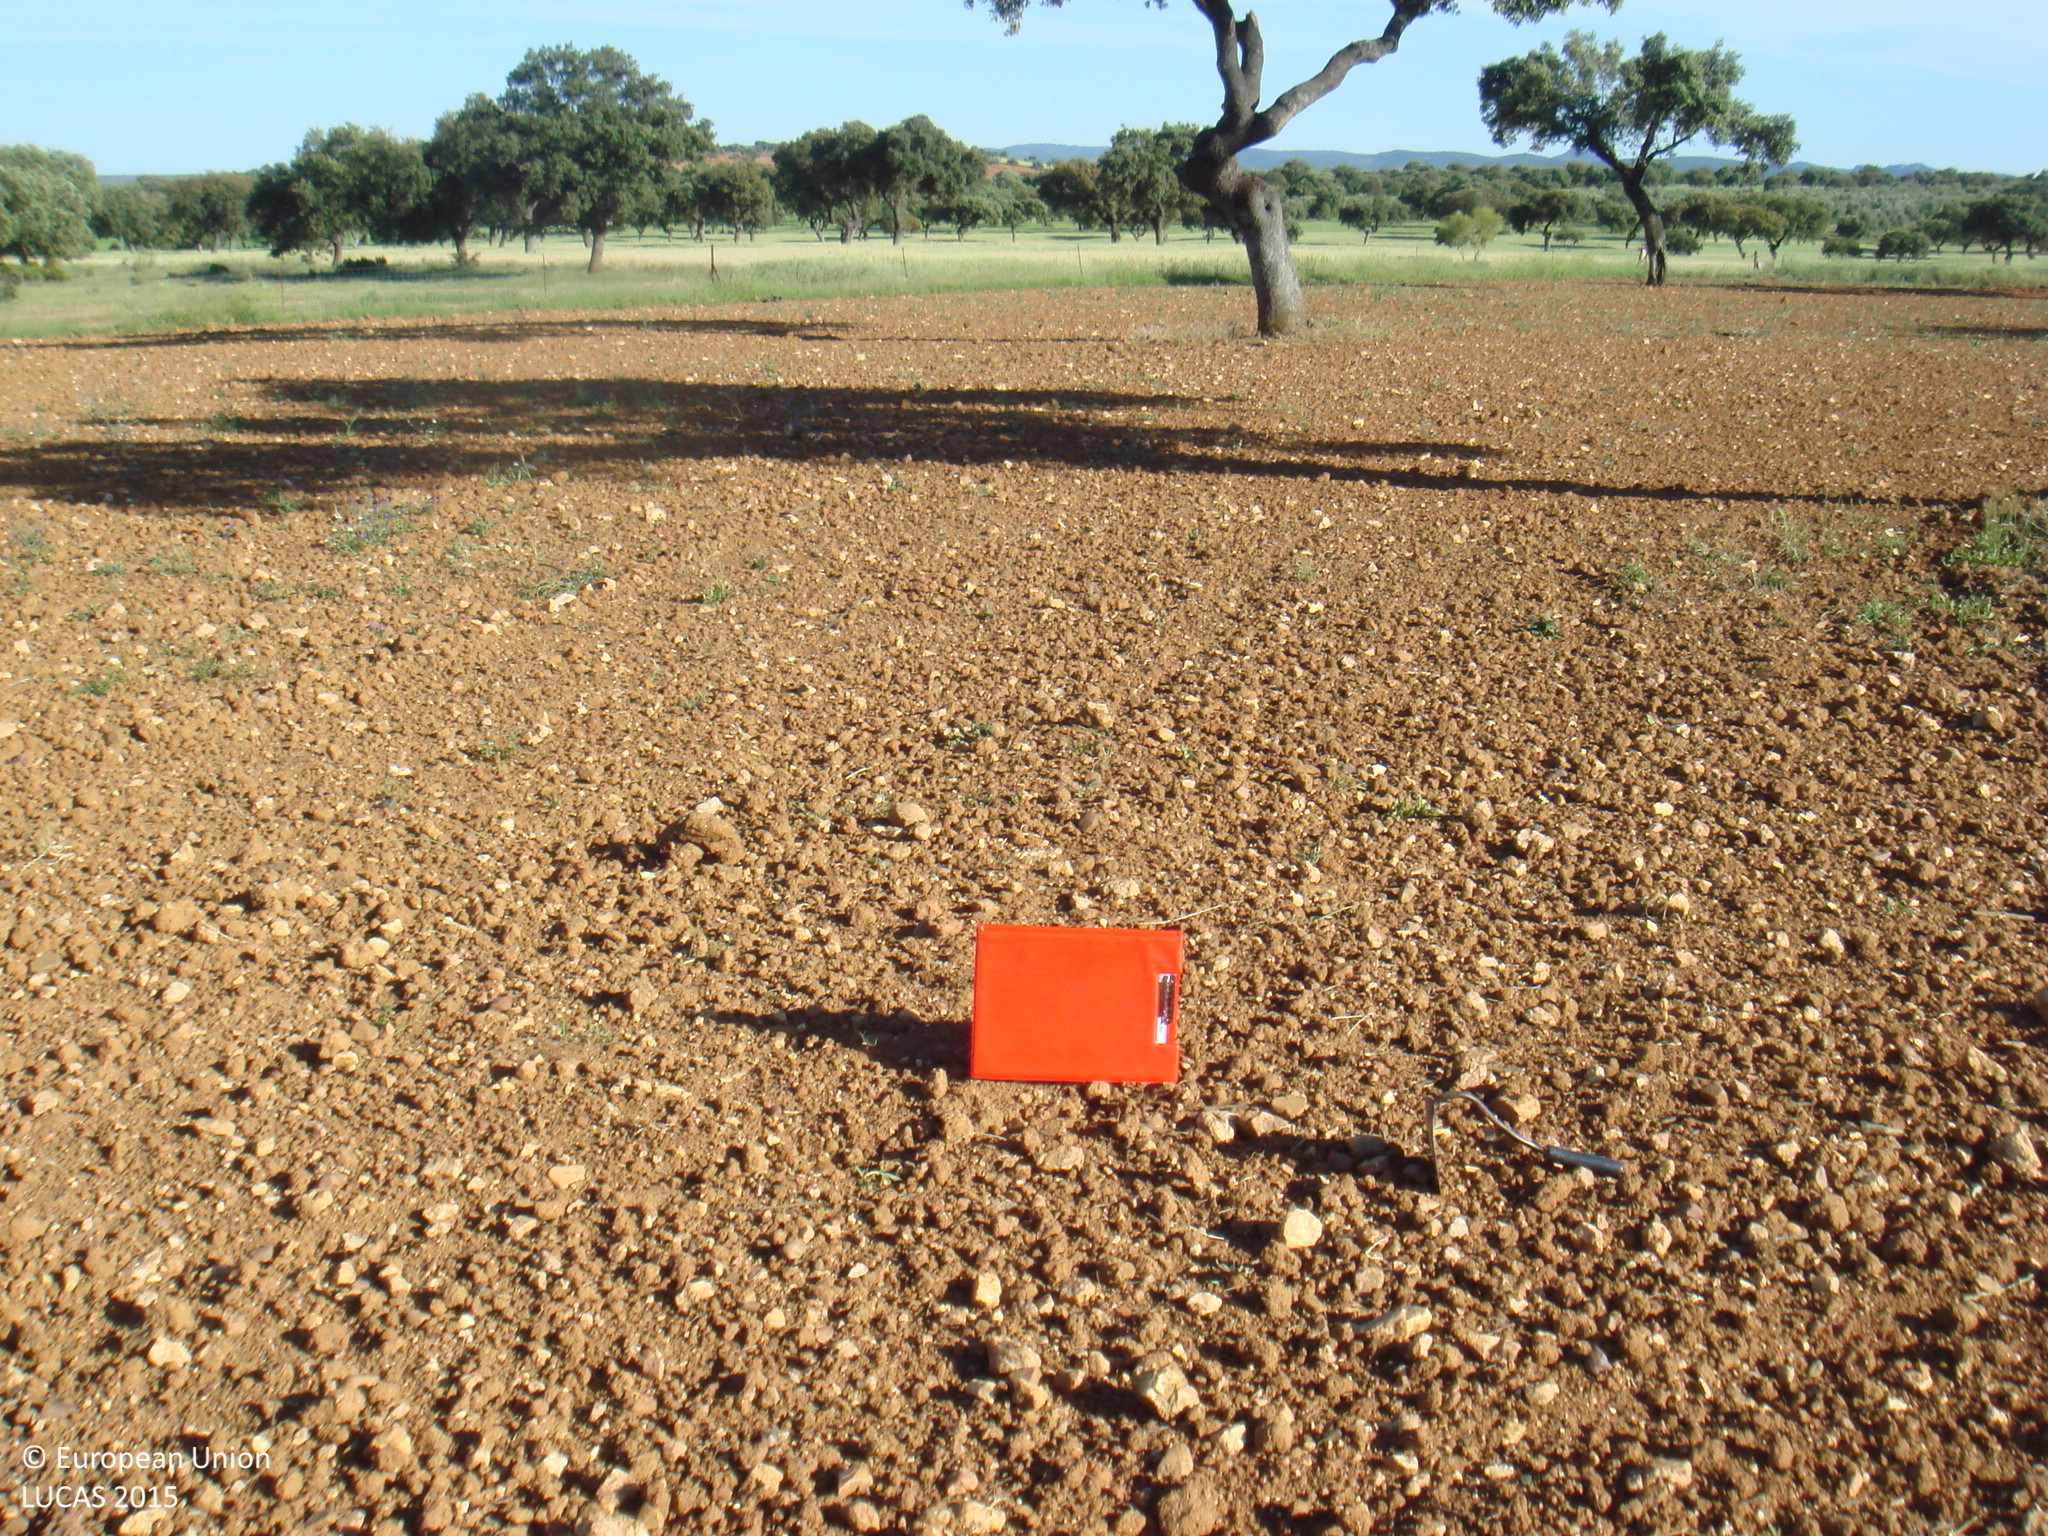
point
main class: Woodland
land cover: Broadleaved woodland
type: broadleaved evergreen forest
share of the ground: 10 - 25 %
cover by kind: unconsolidated bare surface 75 %, broadleaved forest trees 20 %, herbaceous plants 5 %
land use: Agriculture (excluding fallow land and kitchen gardens)
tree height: > 5 m
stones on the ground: 25 - 50 %
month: April
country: ES
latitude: 38.4236
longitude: -5.1366
